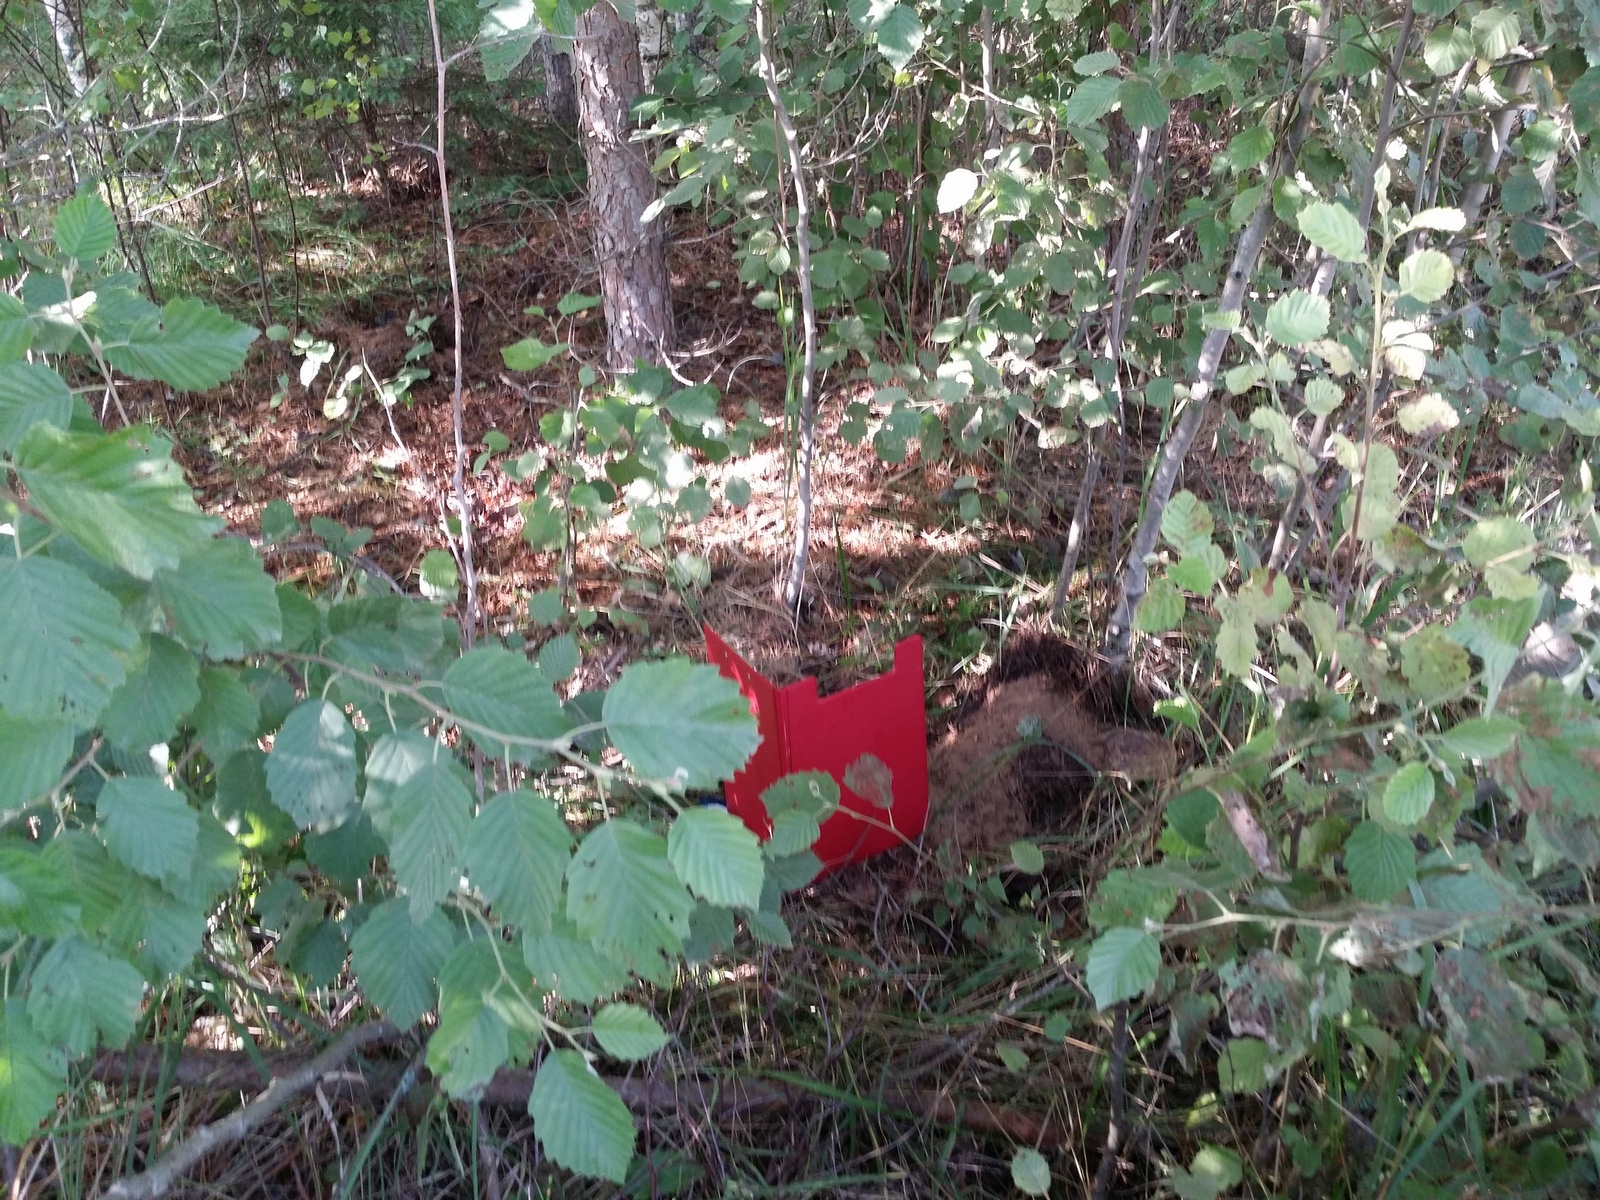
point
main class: Woodland
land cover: Pine dominated mixed woodland
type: hemiboreal forest and nemoral coniferous forest and mixed broadleaved-coniferous forest
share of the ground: 50 - 75 %
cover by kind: coniferous forest trees 45 %, broadleaved forest trees 25 %, lichens and mosses 25 %, herbaceous plants 5 %
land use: Forestry
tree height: < 5 m
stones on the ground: < 10 %
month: August
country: LV
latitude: 57.5365
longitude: 26.8053
